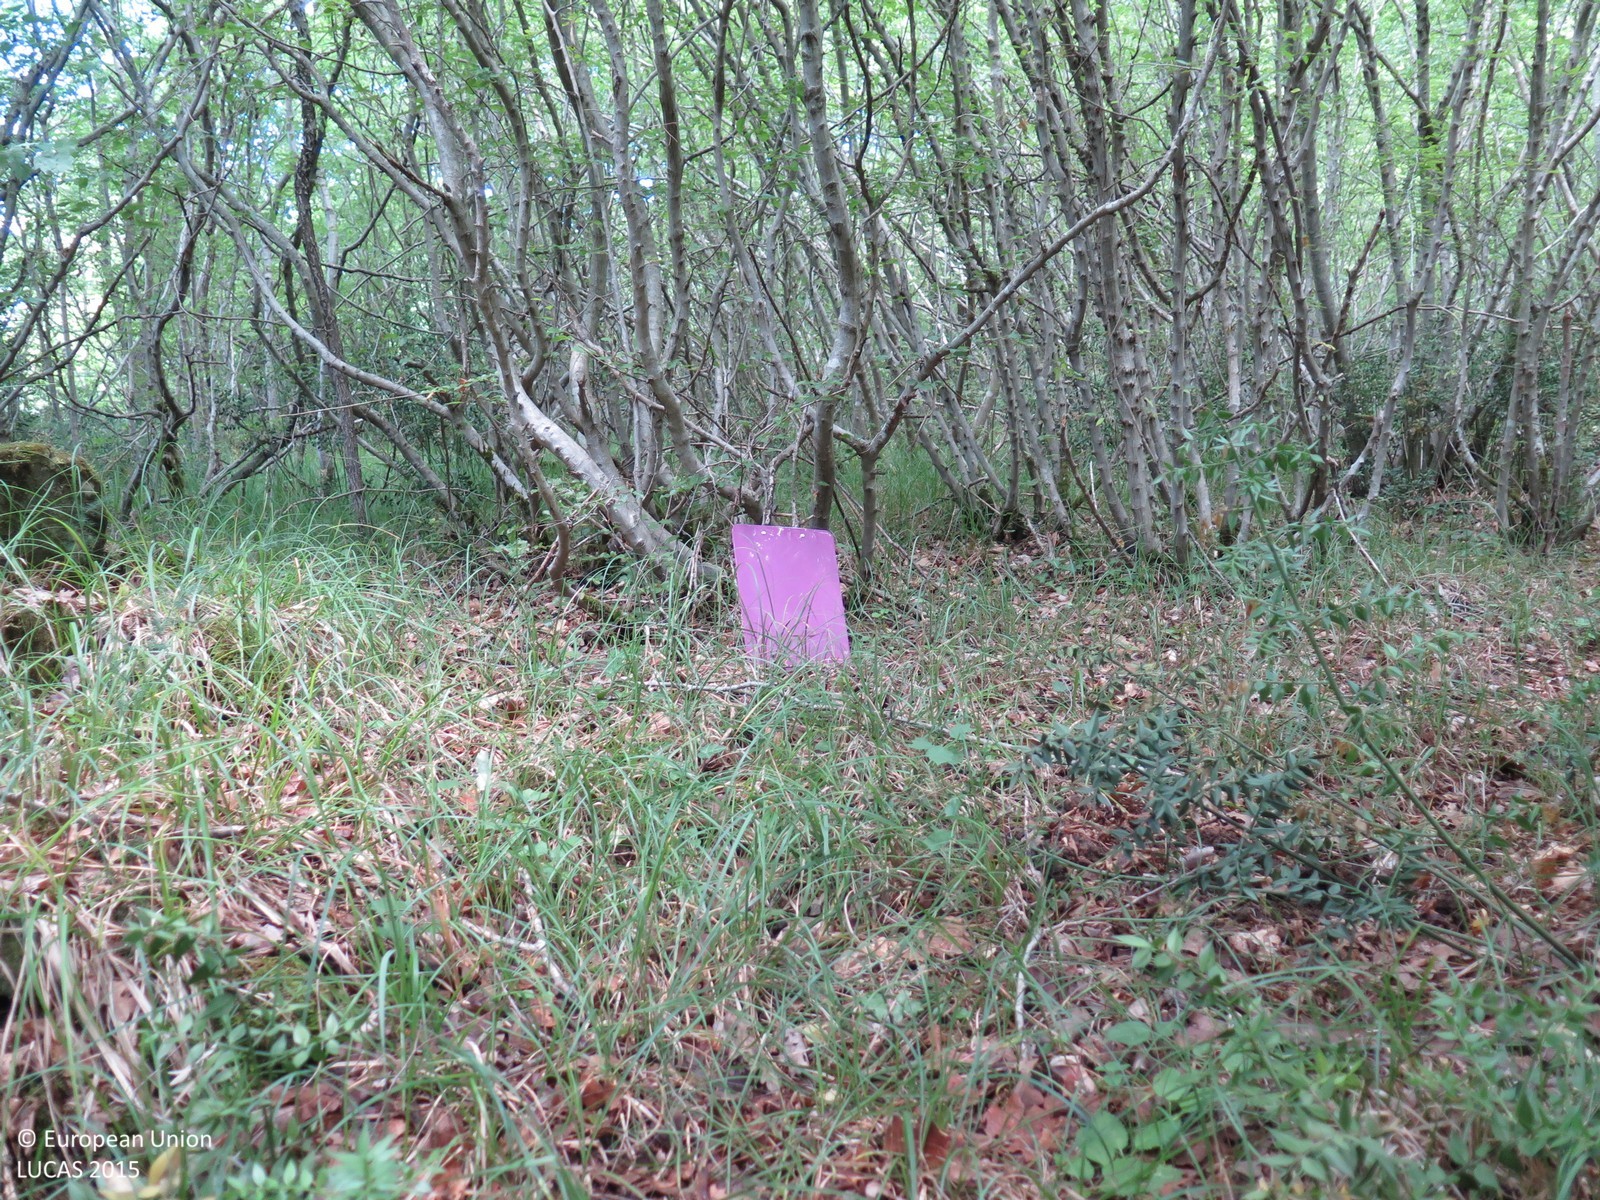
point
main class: Woodland
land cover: Broadleaved woodland
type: beech forest
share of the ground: > 75 %
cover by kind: broadleaved forest trees 90 %, shrubs 5 %, herbaceous plants 5 %
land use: Semi-natural and natural areas not in use
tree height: > 5 m
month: June
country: HR
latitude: 45.2437
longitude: 13.6258
